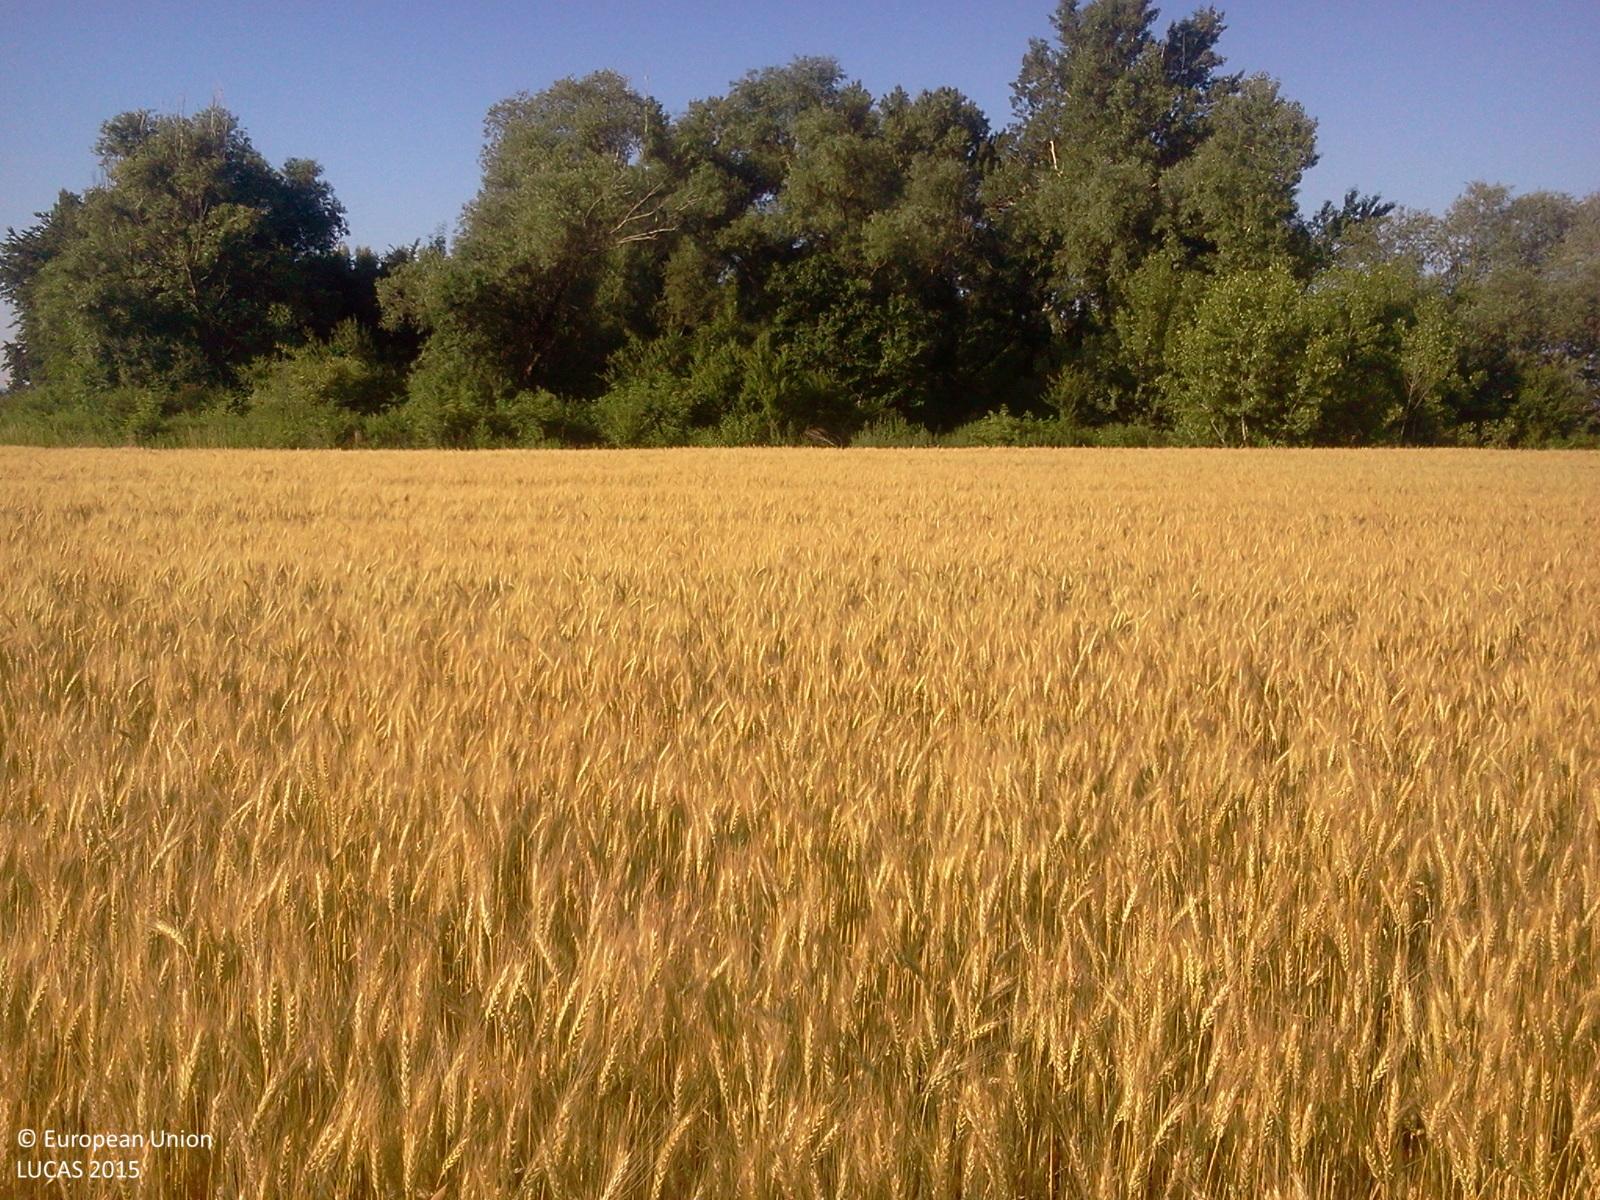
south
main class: Cropland
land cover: Durum wheat
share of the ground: > 75 %
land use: Agriculture (excluding fallow land and kitchen gardens)
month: June
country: HU
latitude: 47.0515
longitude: 17.1531
